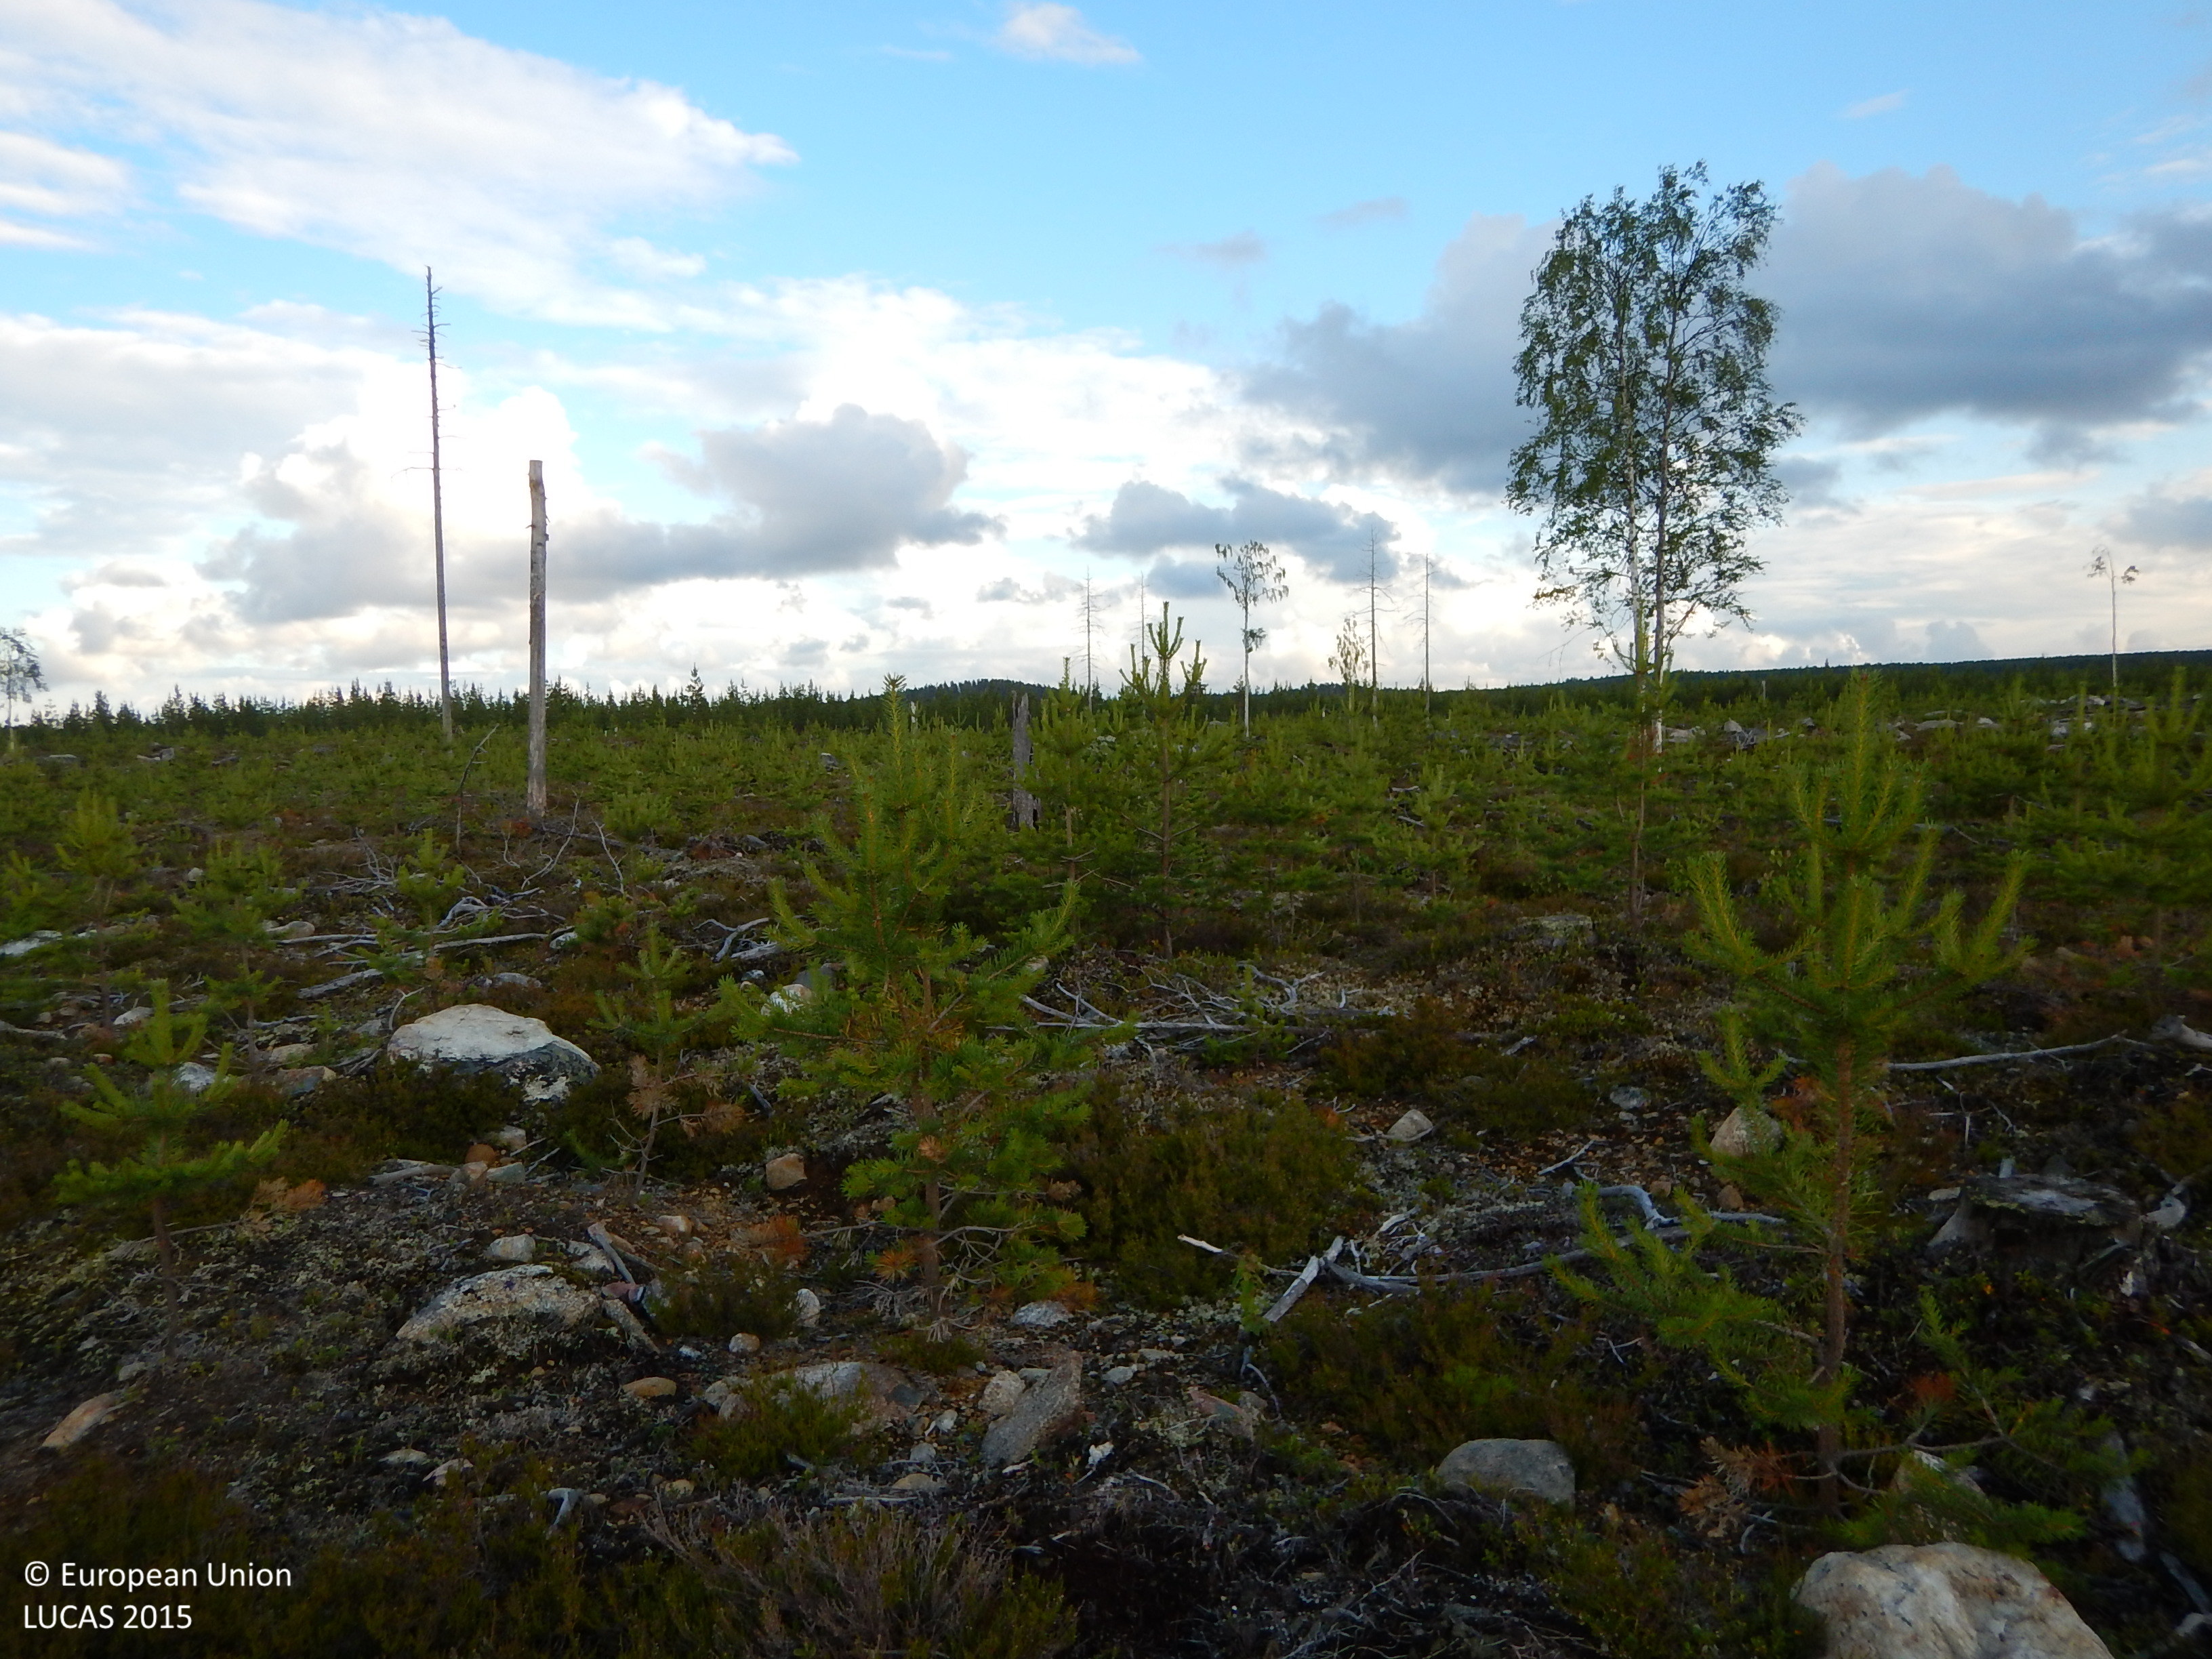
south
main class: Woodland
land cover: Pine dominated coniferous woodland
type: boreal forest
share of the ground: 10 - 25 %
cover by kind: lichens and mosses 30 %, shrubs 20 %, unconsolidated bare surface 20 %, coniferous forest trees 10 %, herbaceous plants 10 %, consolidated bare surface 10 %
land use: Forestry
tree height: < 5 m
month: July
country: SE
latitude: 64.7768
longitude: 20.2573
